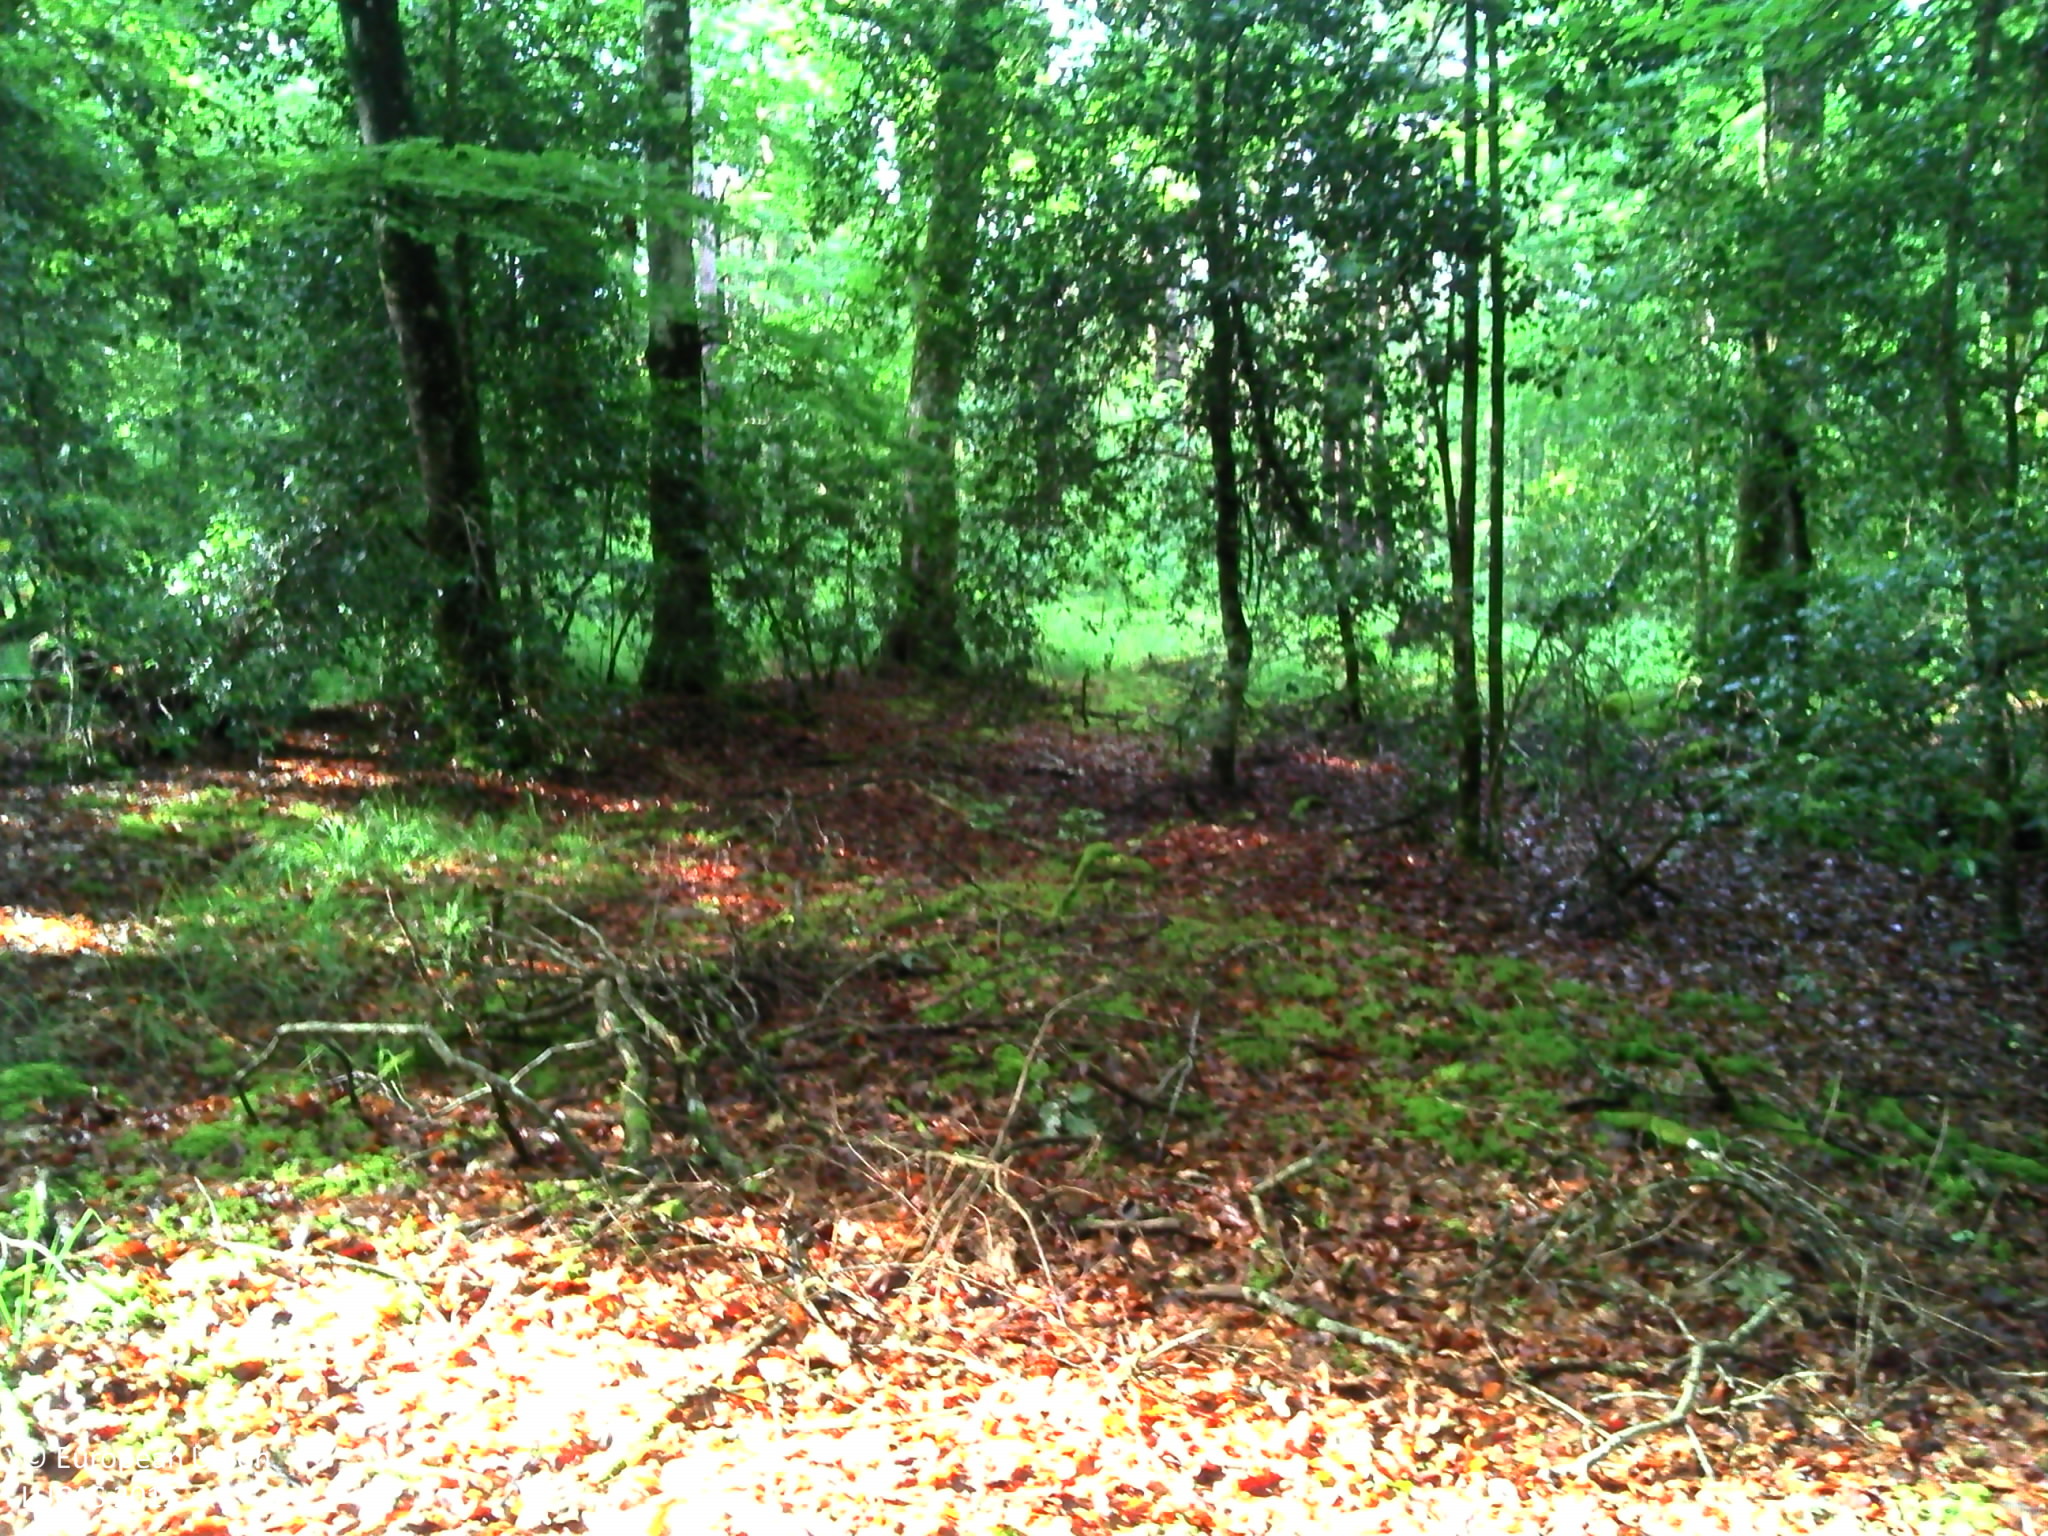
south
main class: Woodland
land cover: Broadleaved woodland
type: acidophilous oak and oak-birch forest
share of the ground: > 75 %
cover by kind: broadleaved forest trees 90 %, herbaceous plants 5 %, lichens and mosses 5 %
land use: Forestry
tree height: > 5 m
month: June
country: FR
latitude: 48.2752
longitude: -1.4857
